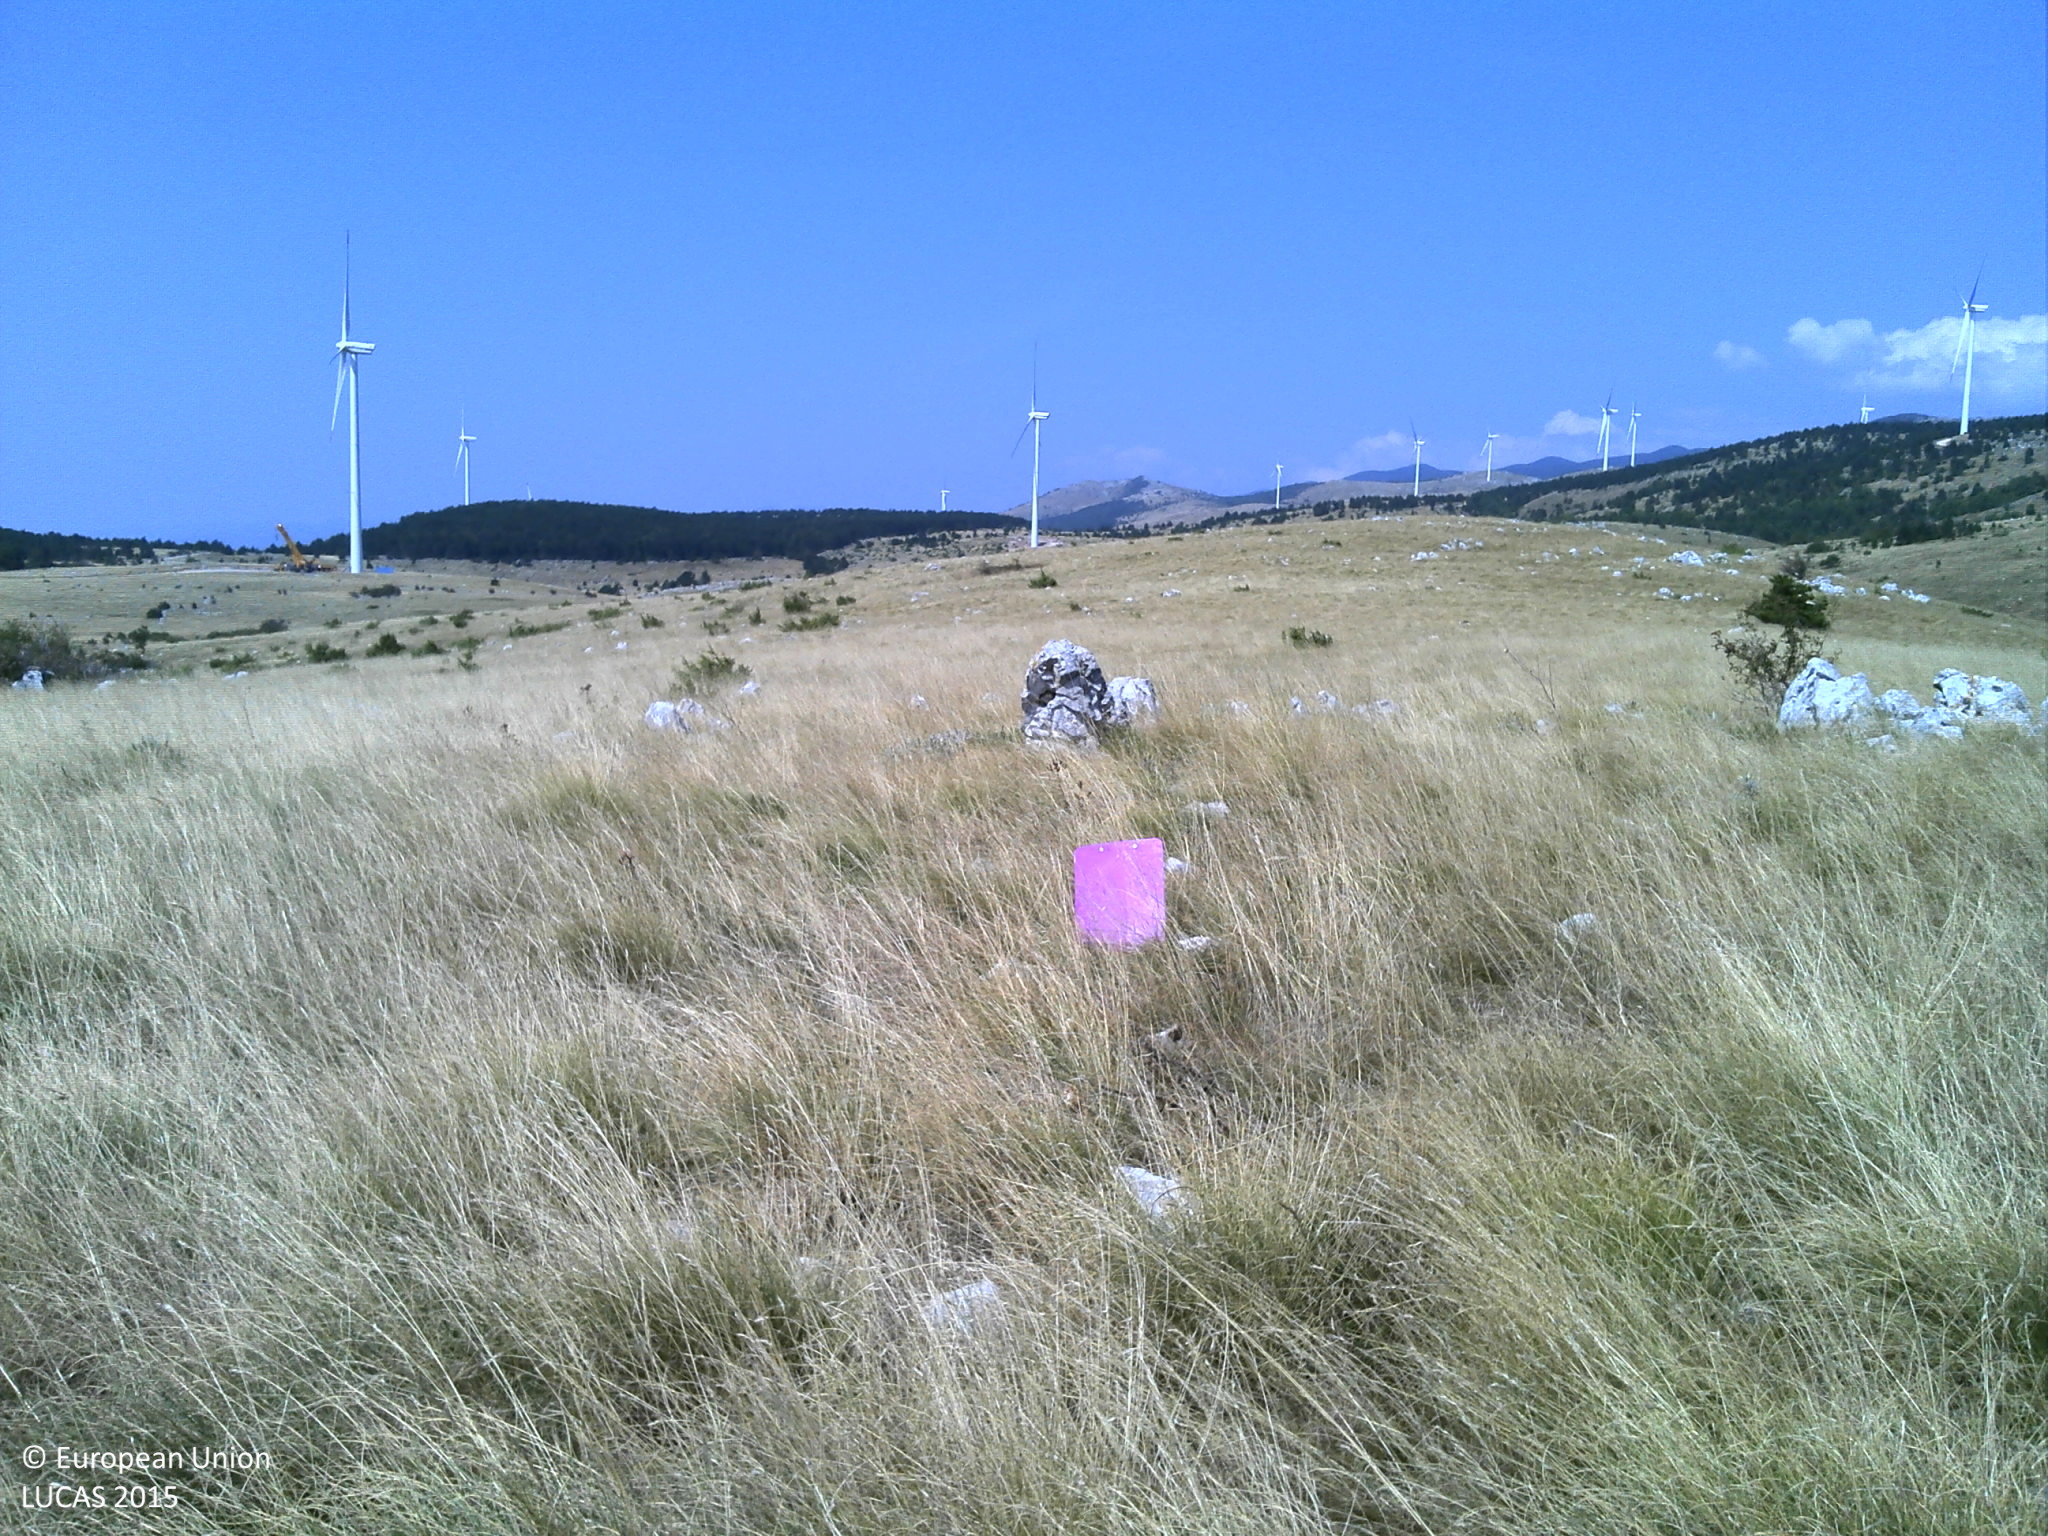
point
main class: Grassland
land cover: Grassland without tree/shrub cover
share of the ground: > 75 %
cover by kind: herbaceous plants 90 %, consolidated bare surface 5 %, unconsolidated bare surface 5 %
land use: Semi-natural and natural areas not in use
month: August
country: HR
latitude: 45.0281
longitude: 14.9316
